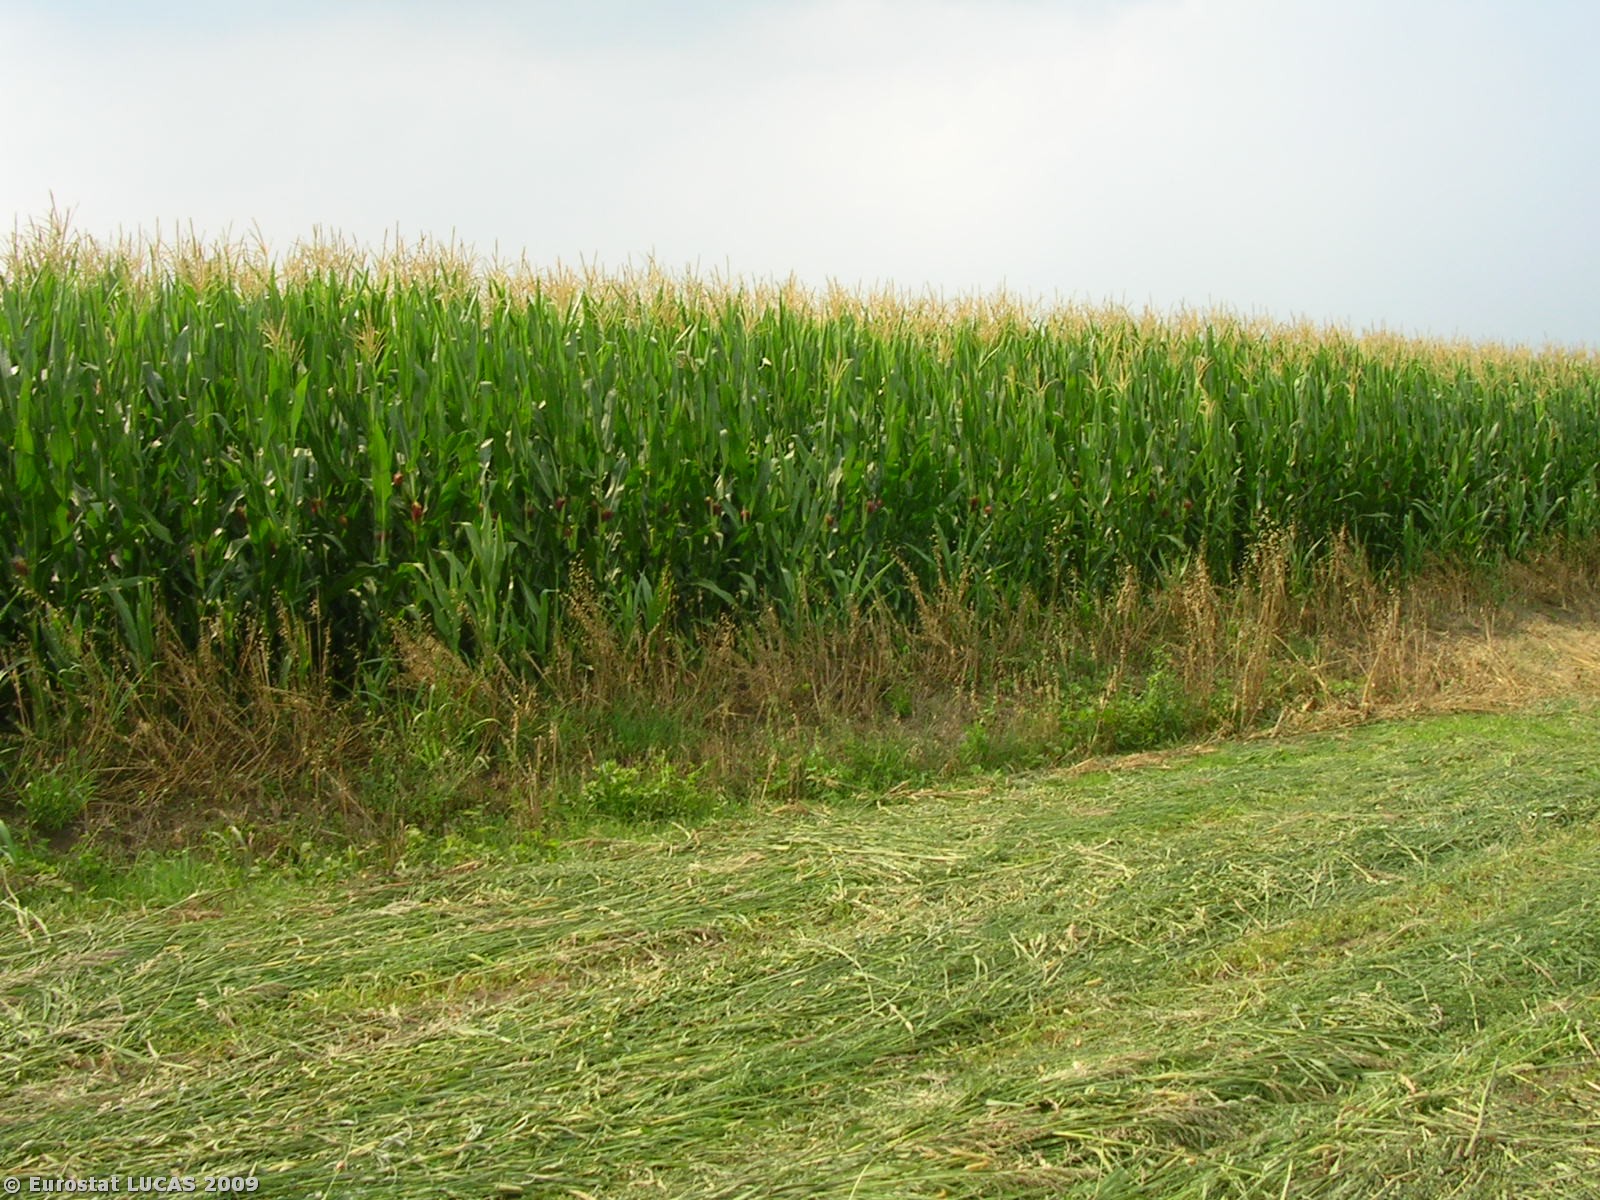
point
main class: Cropland
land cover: Maize
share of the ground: > 75 %
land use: Agriculture (excluding fallow land and kitchen gardens)
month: July
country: IT
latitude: 45.1672
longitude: 11.6383
